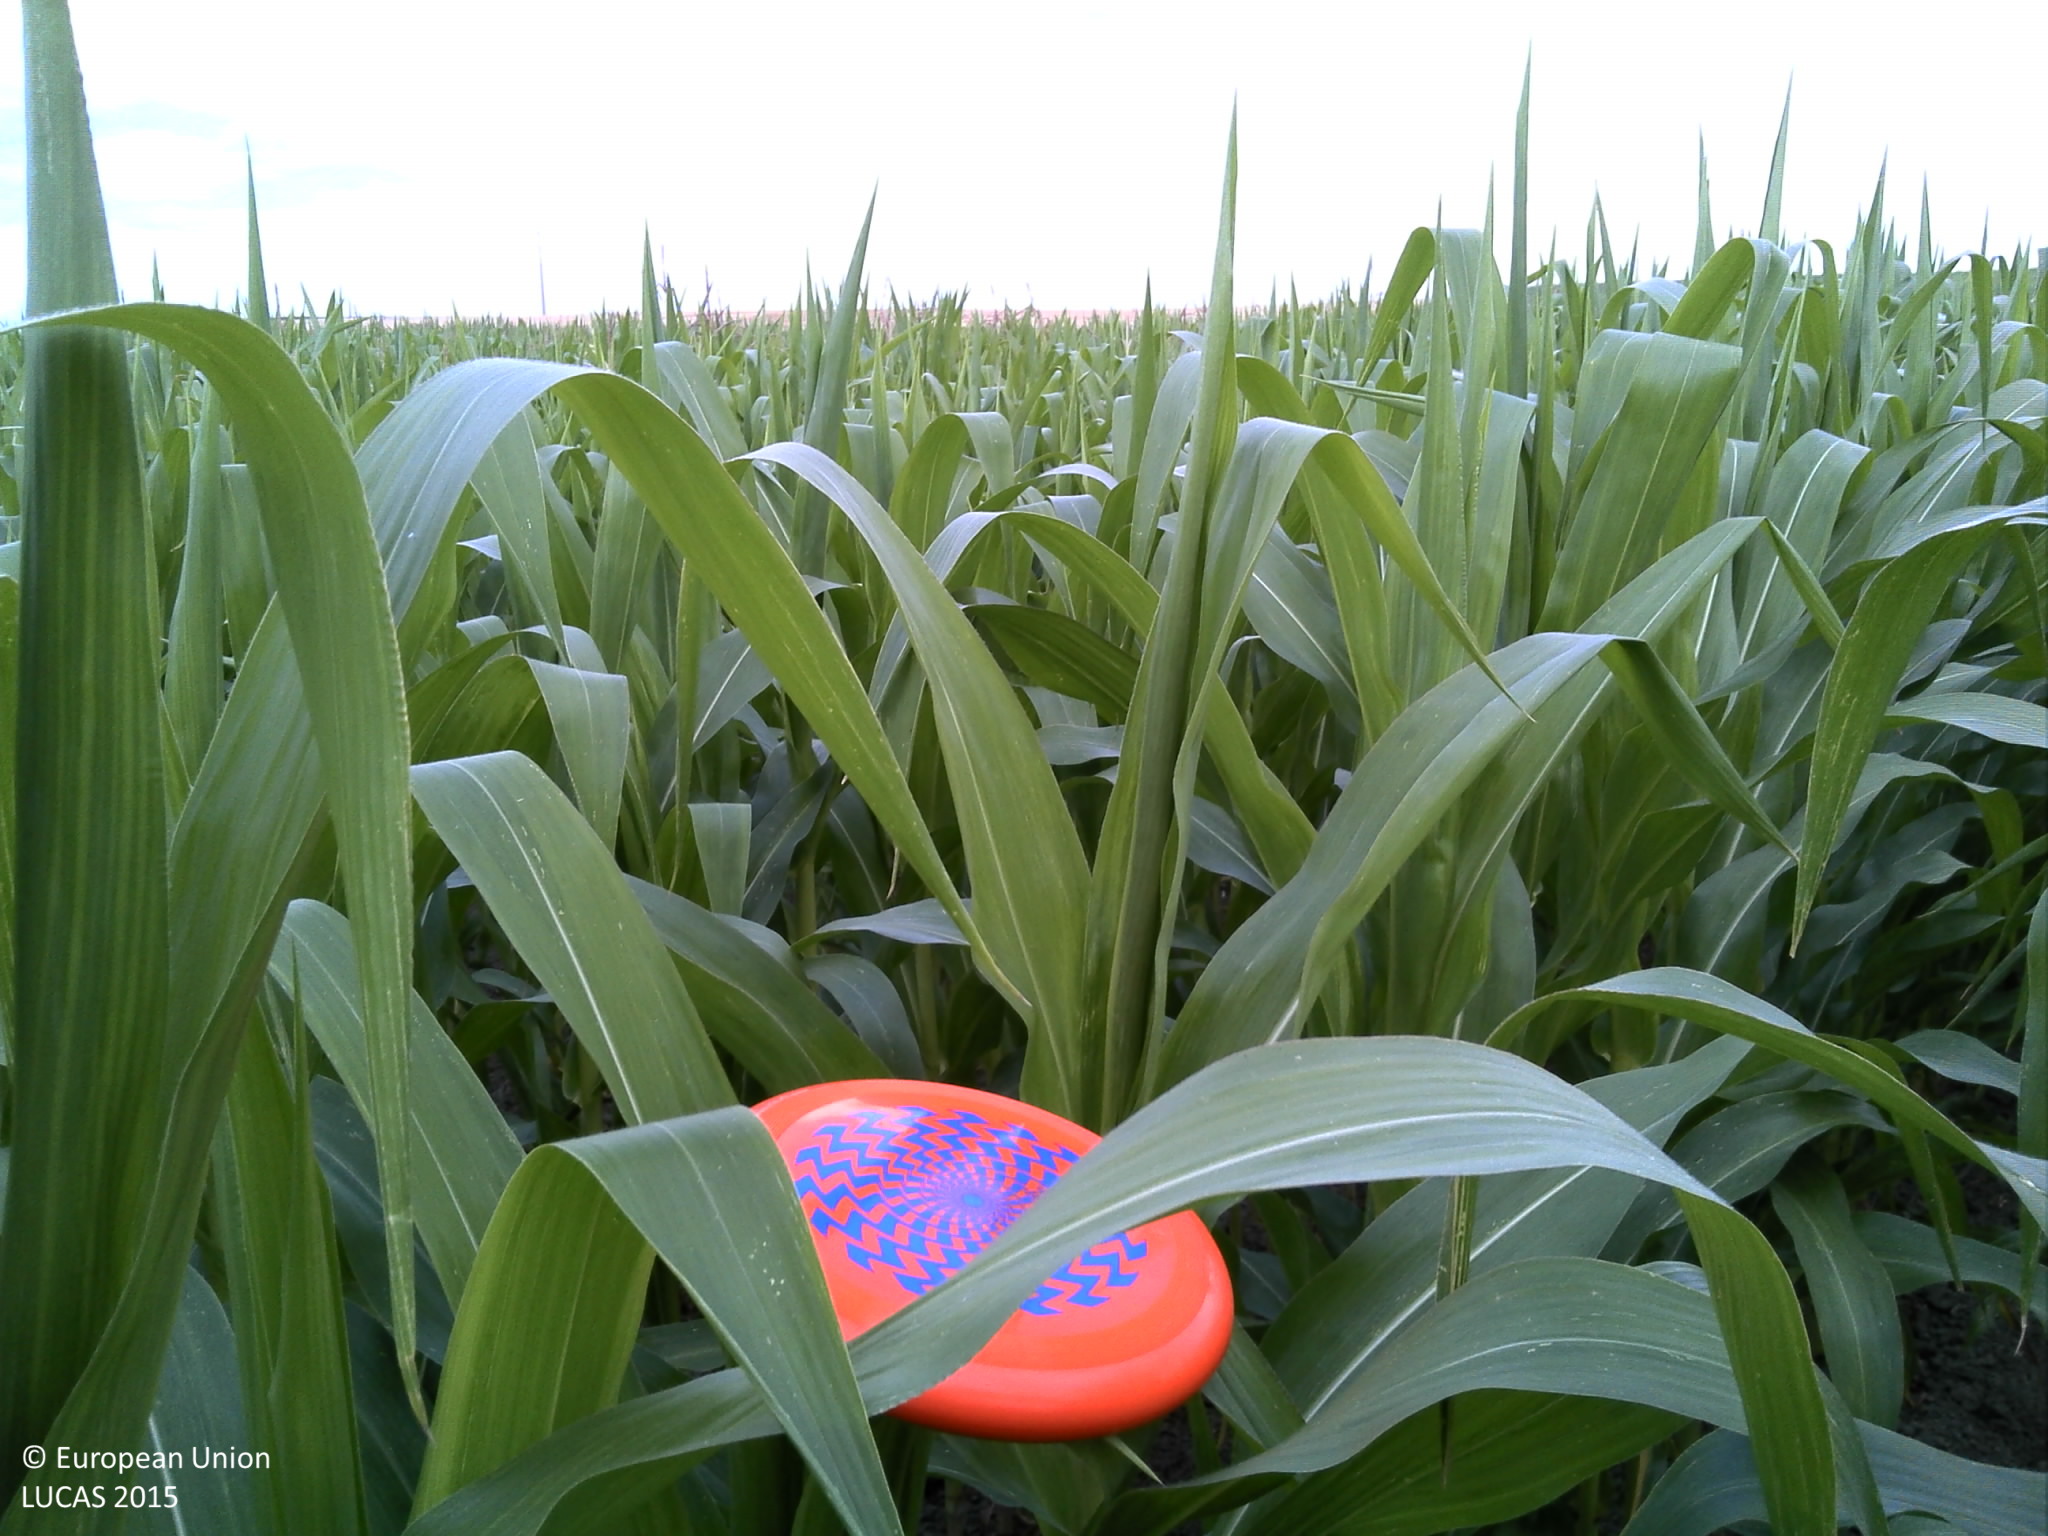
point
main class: Cropland
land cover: Maize
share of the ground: > 75 %
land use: Agriculture (excluding fallow land and kitchen gardens)
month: July
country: FR
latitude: 49.0056
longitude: 4.8712
